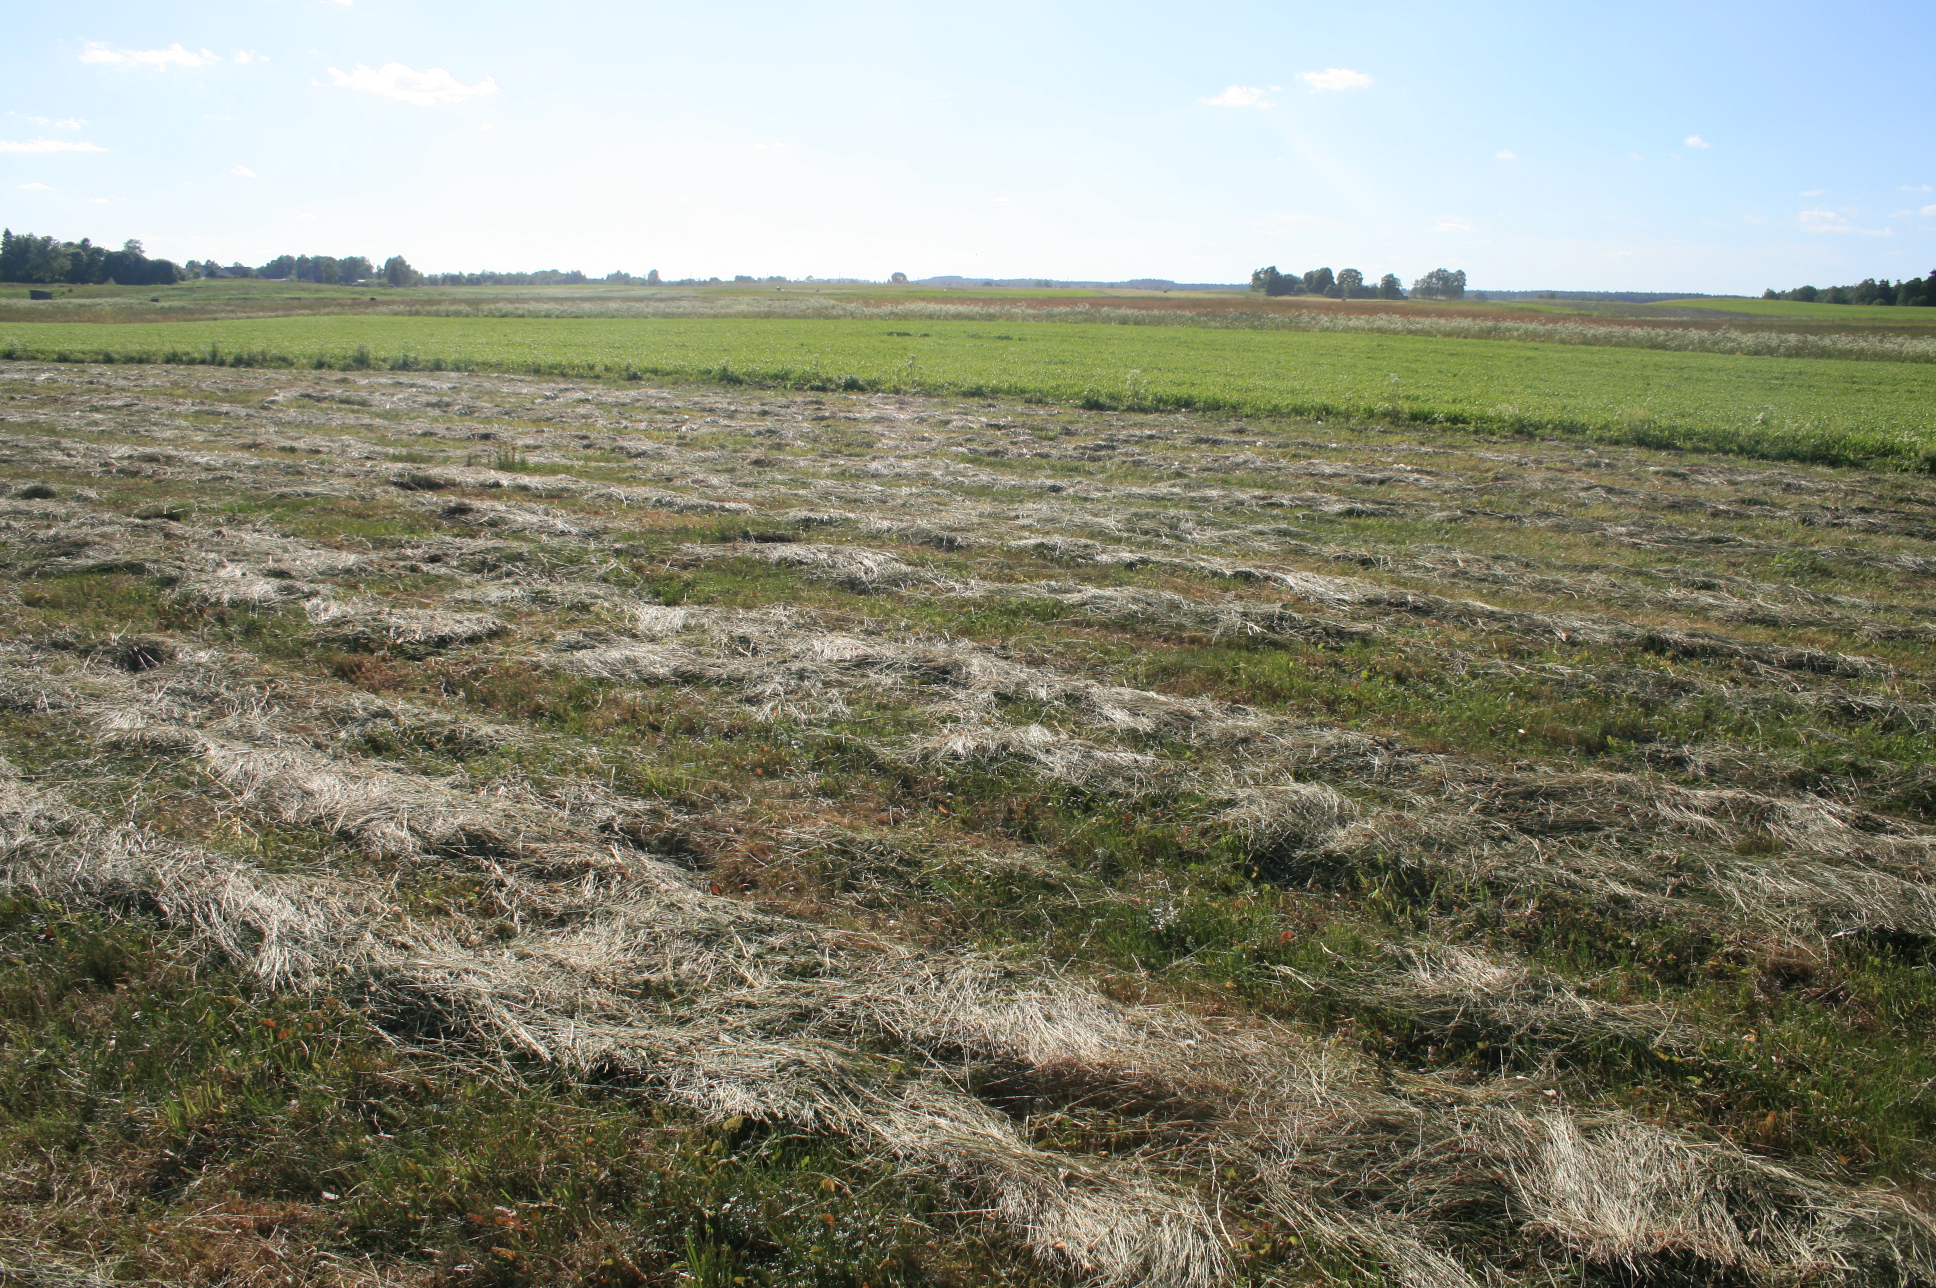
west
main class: Grassland
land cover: Grassland without tree/shrub cover
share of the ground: > 75 %
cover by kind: herbaceous plants 100 %
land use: Agriculture (excluding fallow land and kitchen gardens)
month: June
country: LT
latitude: 55.8206
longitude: 22.3959
